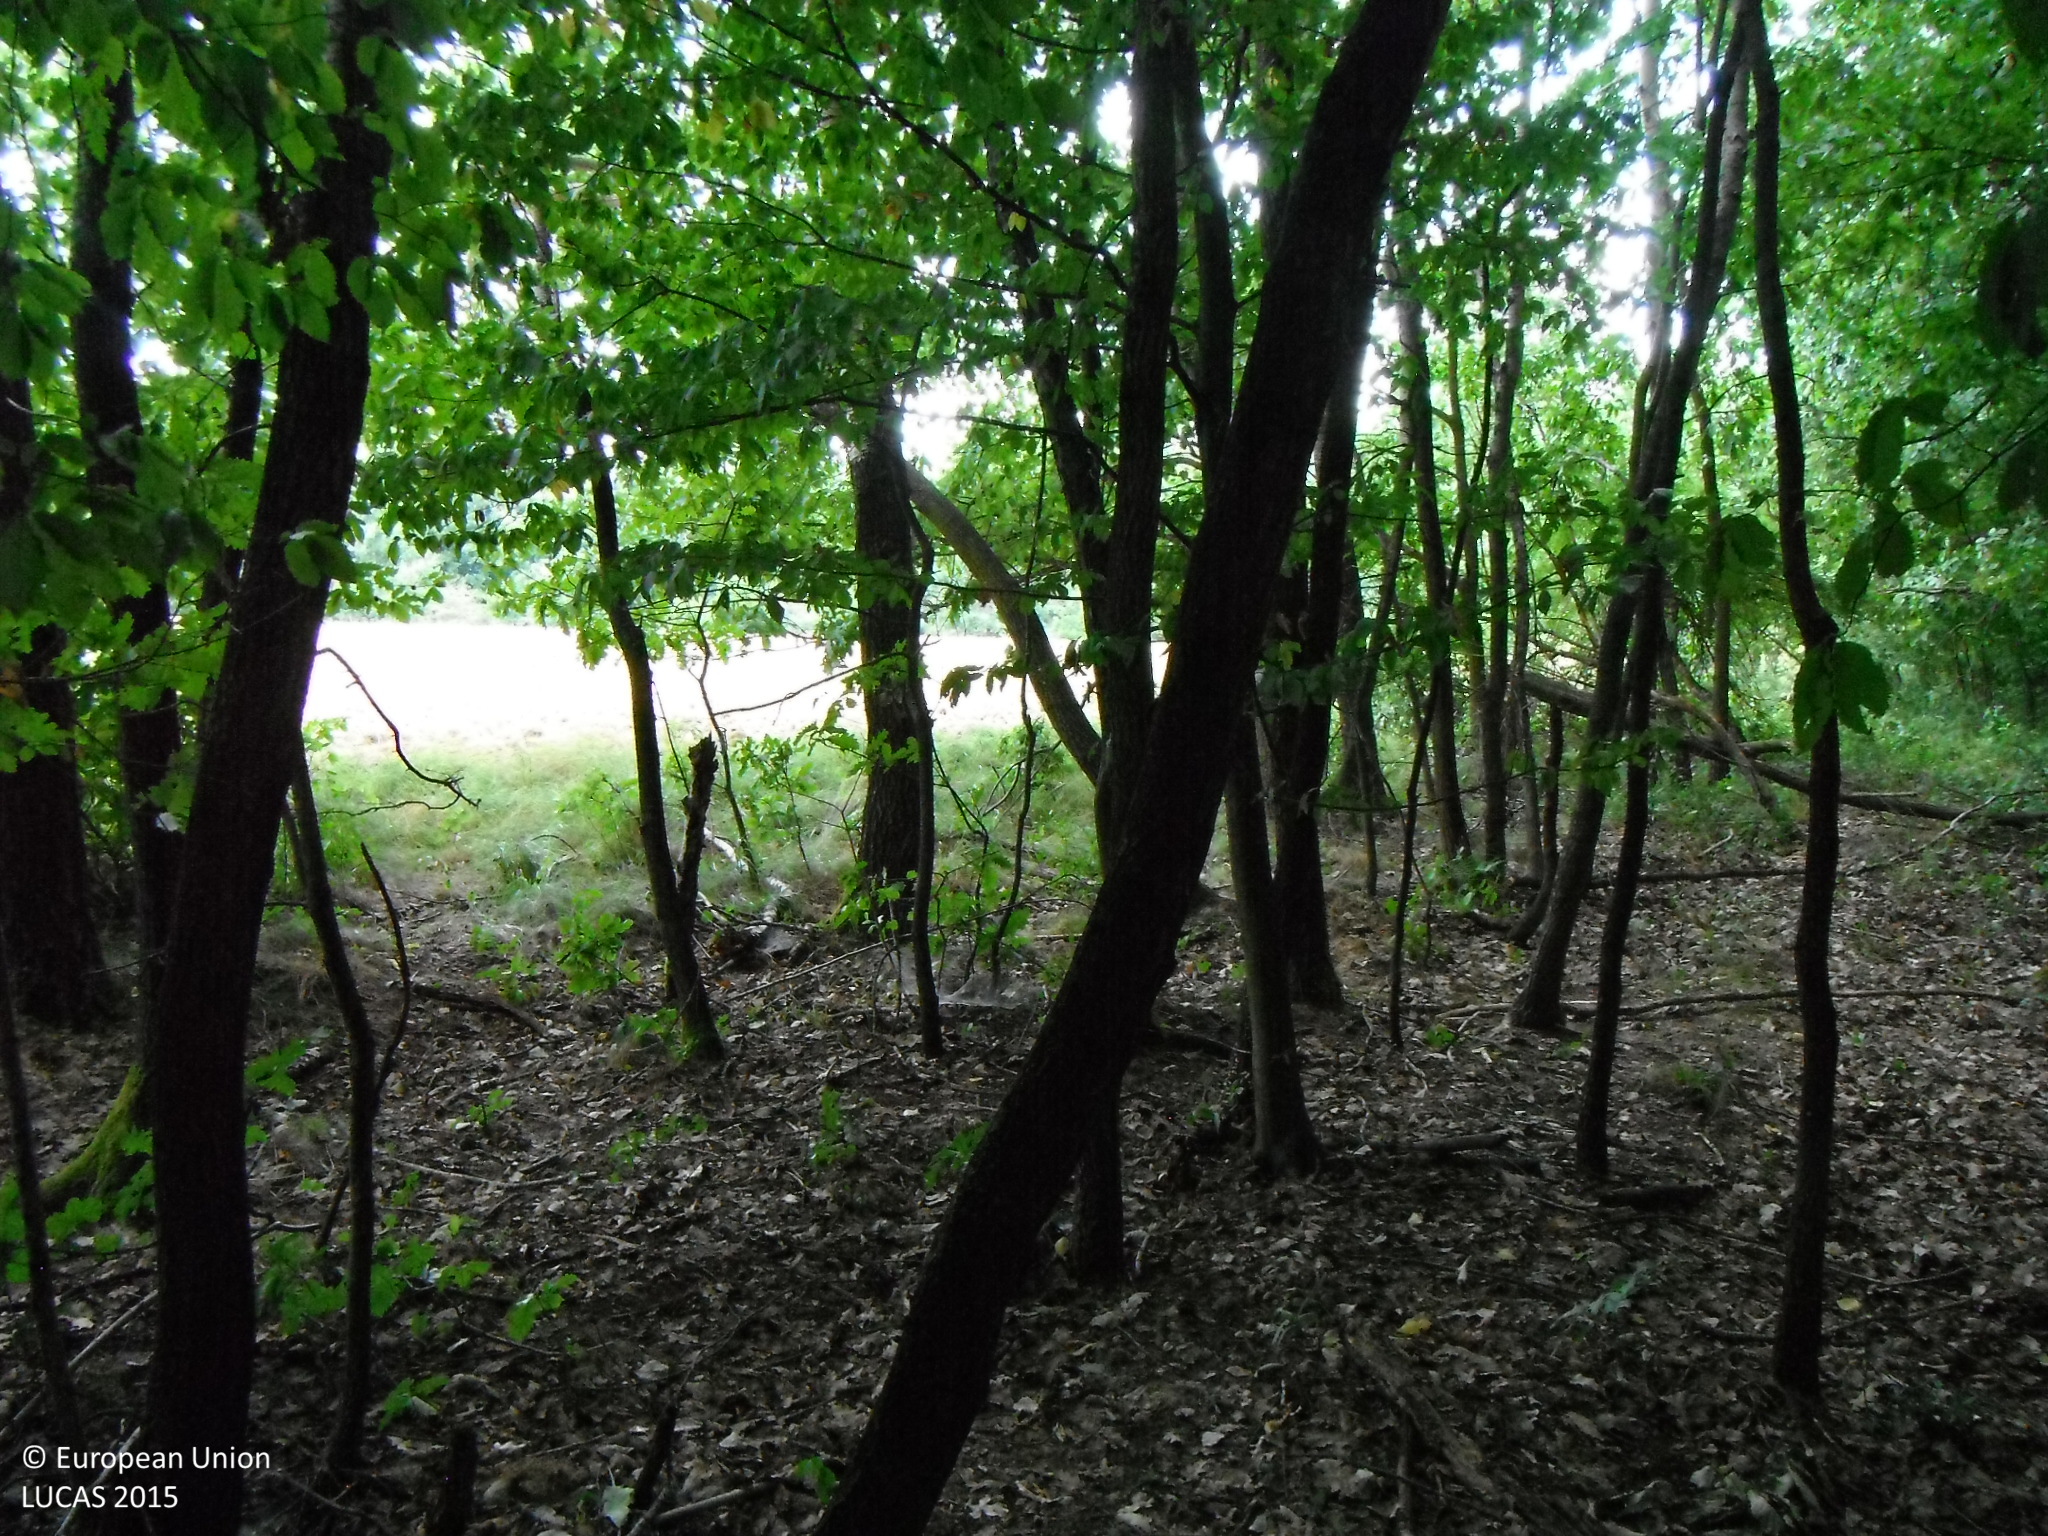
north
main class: Woodland
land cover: Broadleaved woodland
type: mesophytic deciduous forest
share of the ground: > 75 %
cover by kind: broadleaved forest trees 100 %
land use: Forestry
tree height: > 5 m
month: July
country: SK
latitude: 48.3300
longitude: 19.9972
